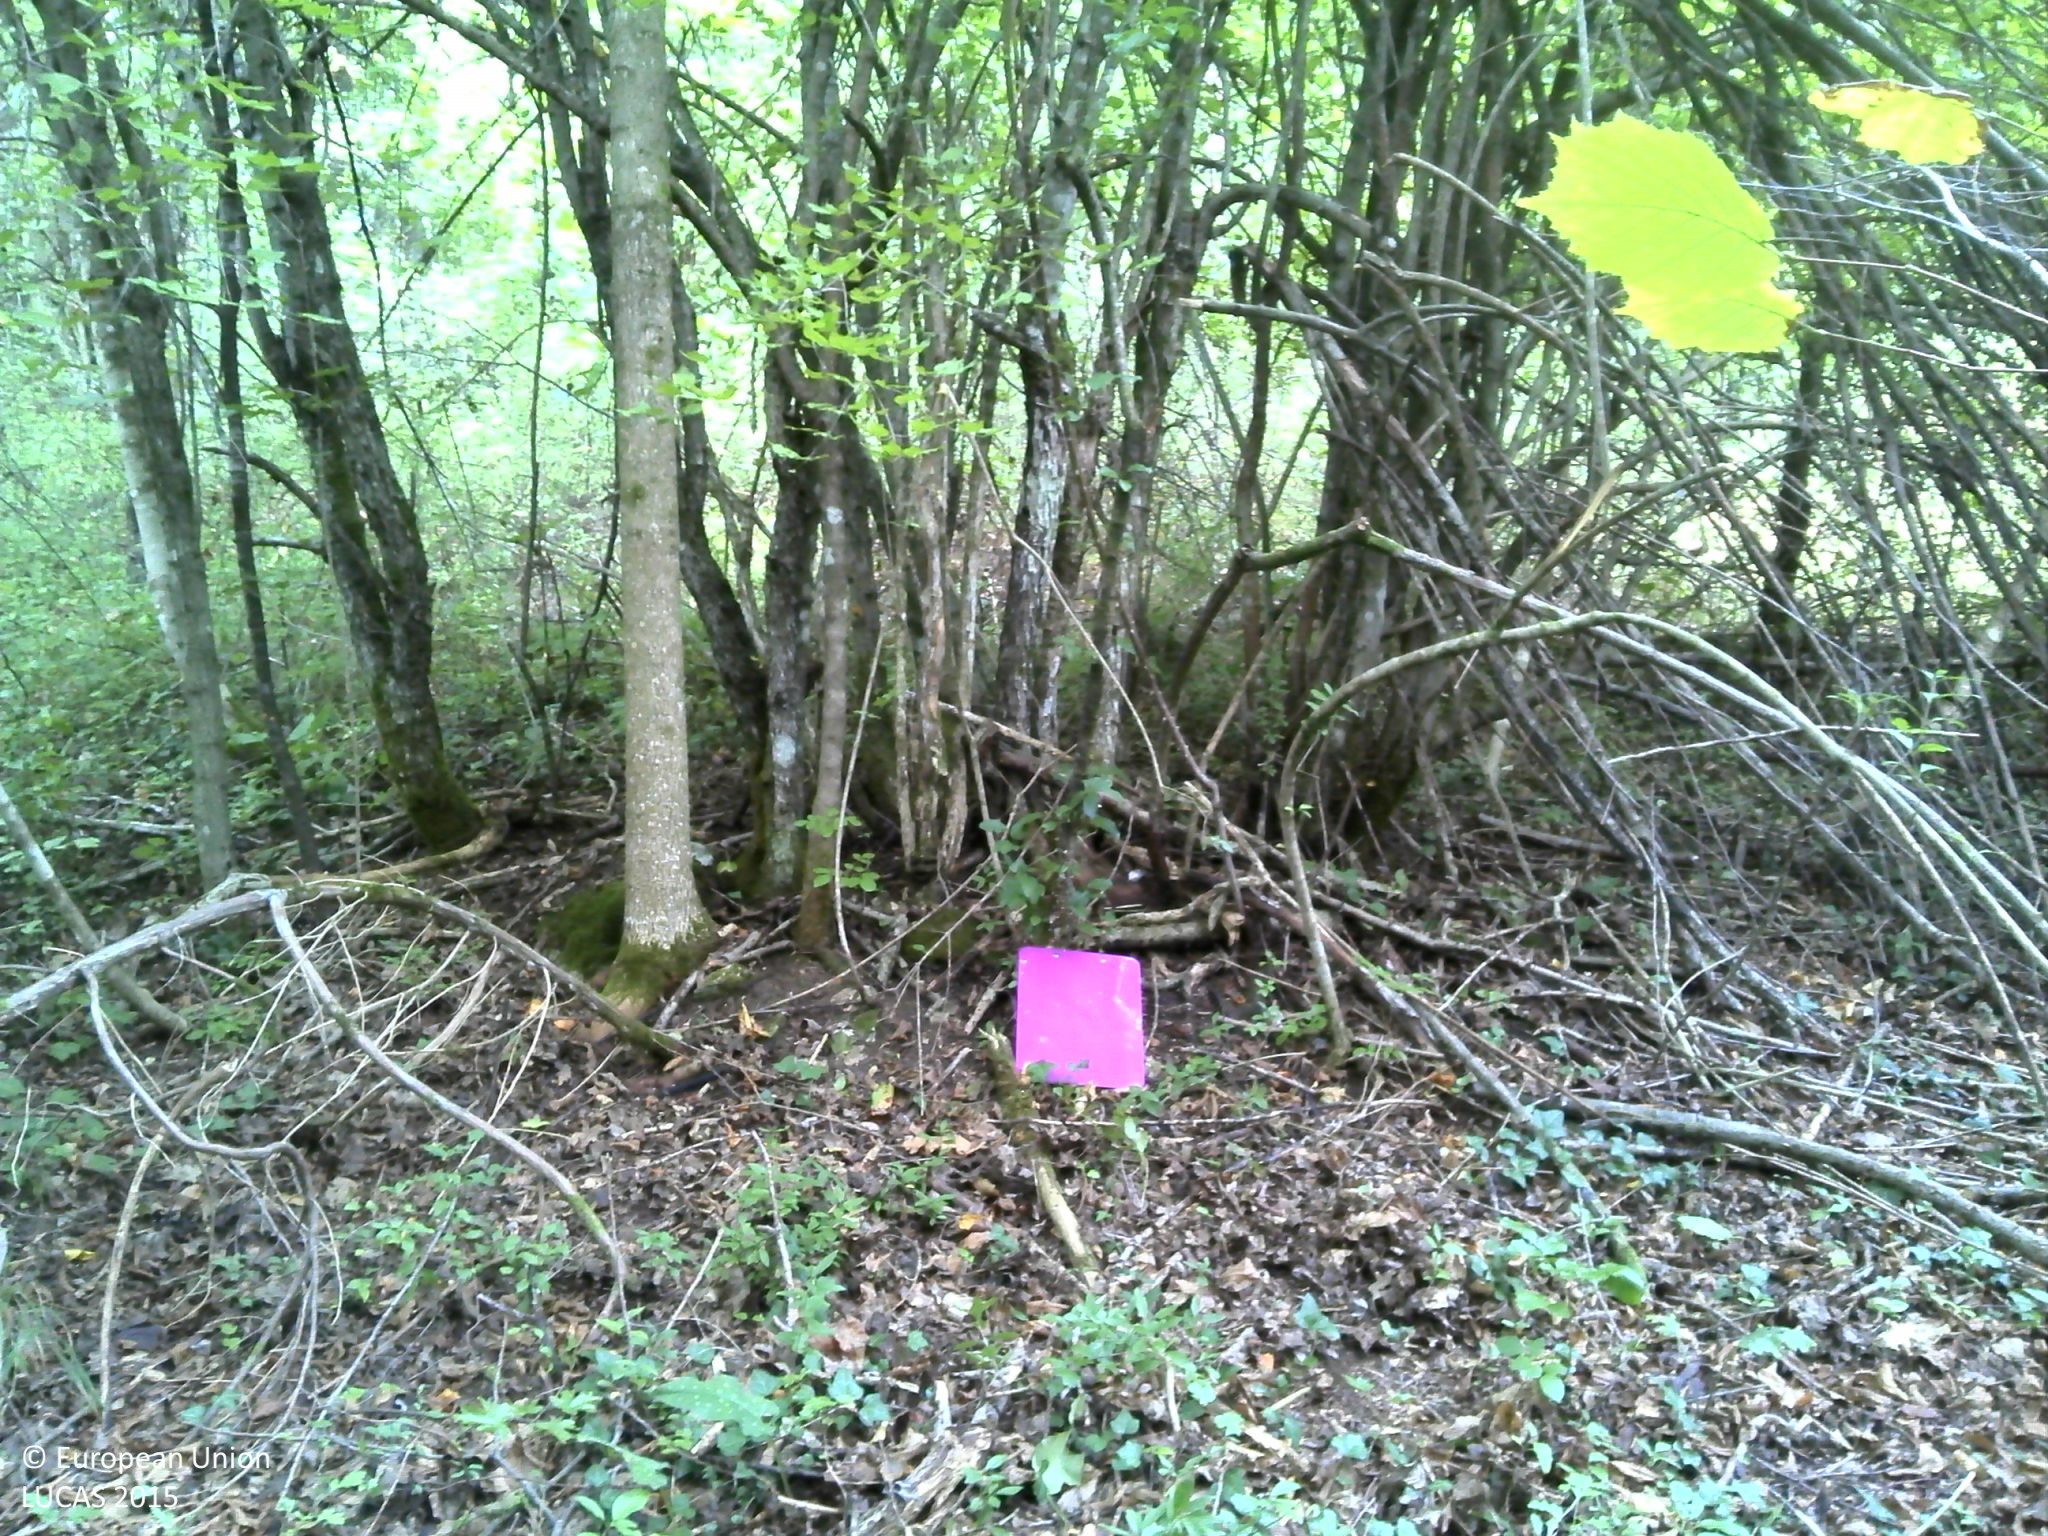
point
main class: Woodland
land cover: Broadleaved woodland
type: beech forest
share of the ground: > 75 %
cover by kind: broadleaved forest trees 100 %
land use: Forestry
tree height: > 5 m
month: September
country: HR
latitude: 45.1748
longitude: 15.6070
